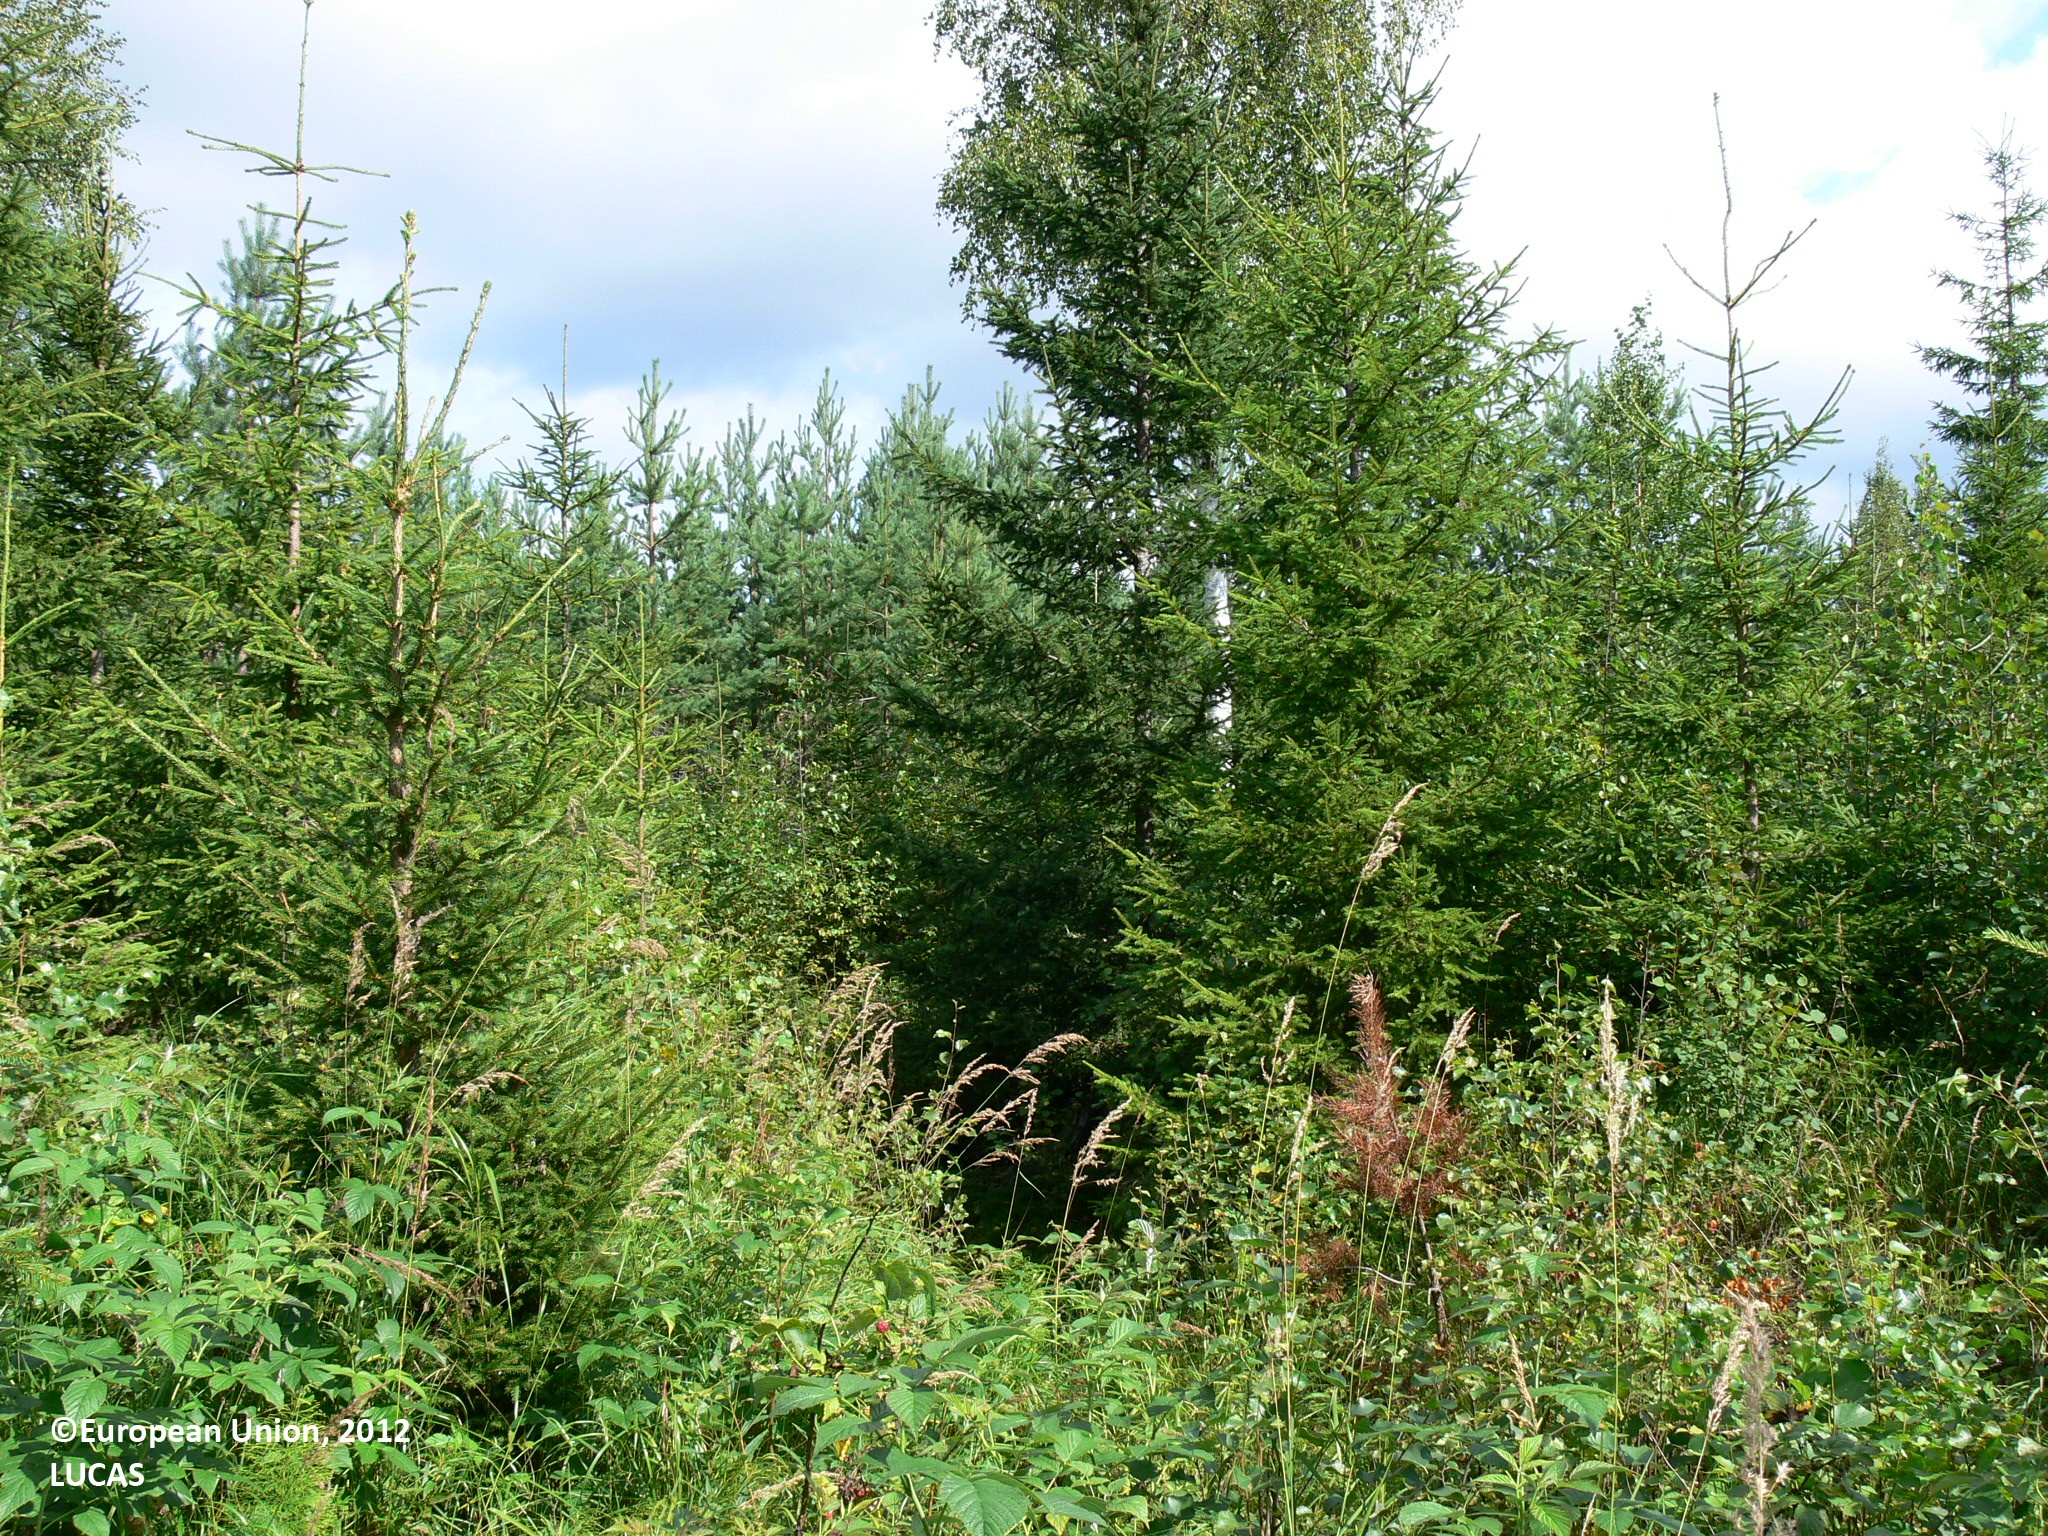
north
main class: Woodland
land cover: Spruce dominated mixed woodland
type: boreal forest
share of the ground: 50 - 75 %
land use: Forestry
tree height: < 5 m
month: August
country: FI
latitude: 61.9608
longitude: 29.2873
